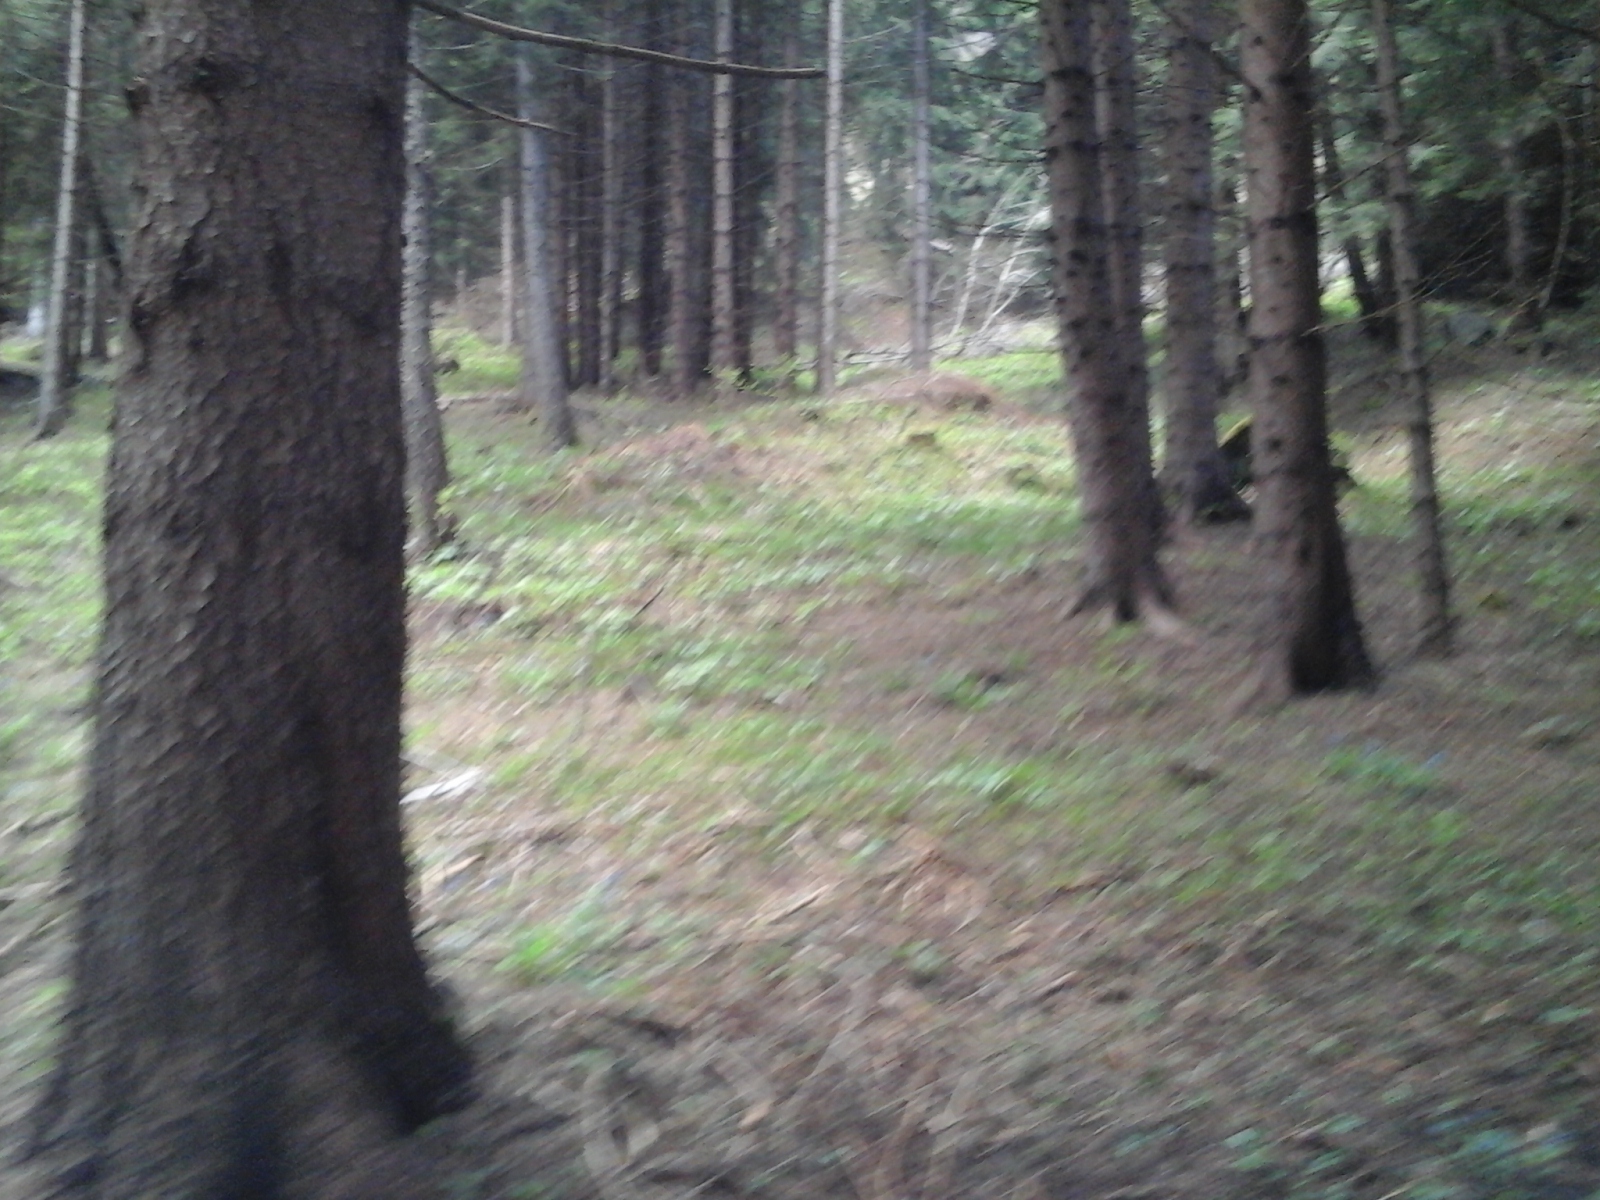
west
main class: Woodland
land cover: Spruce dominated coniferous woodland
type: alpine coniferous forest
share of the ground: > 75 %
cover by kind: coniferous forest trees 95 %, herbaceous plants 5 %
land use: Forestry
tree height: > 5 m
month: May
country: IT
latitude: 46.2936
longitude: 10.8686
